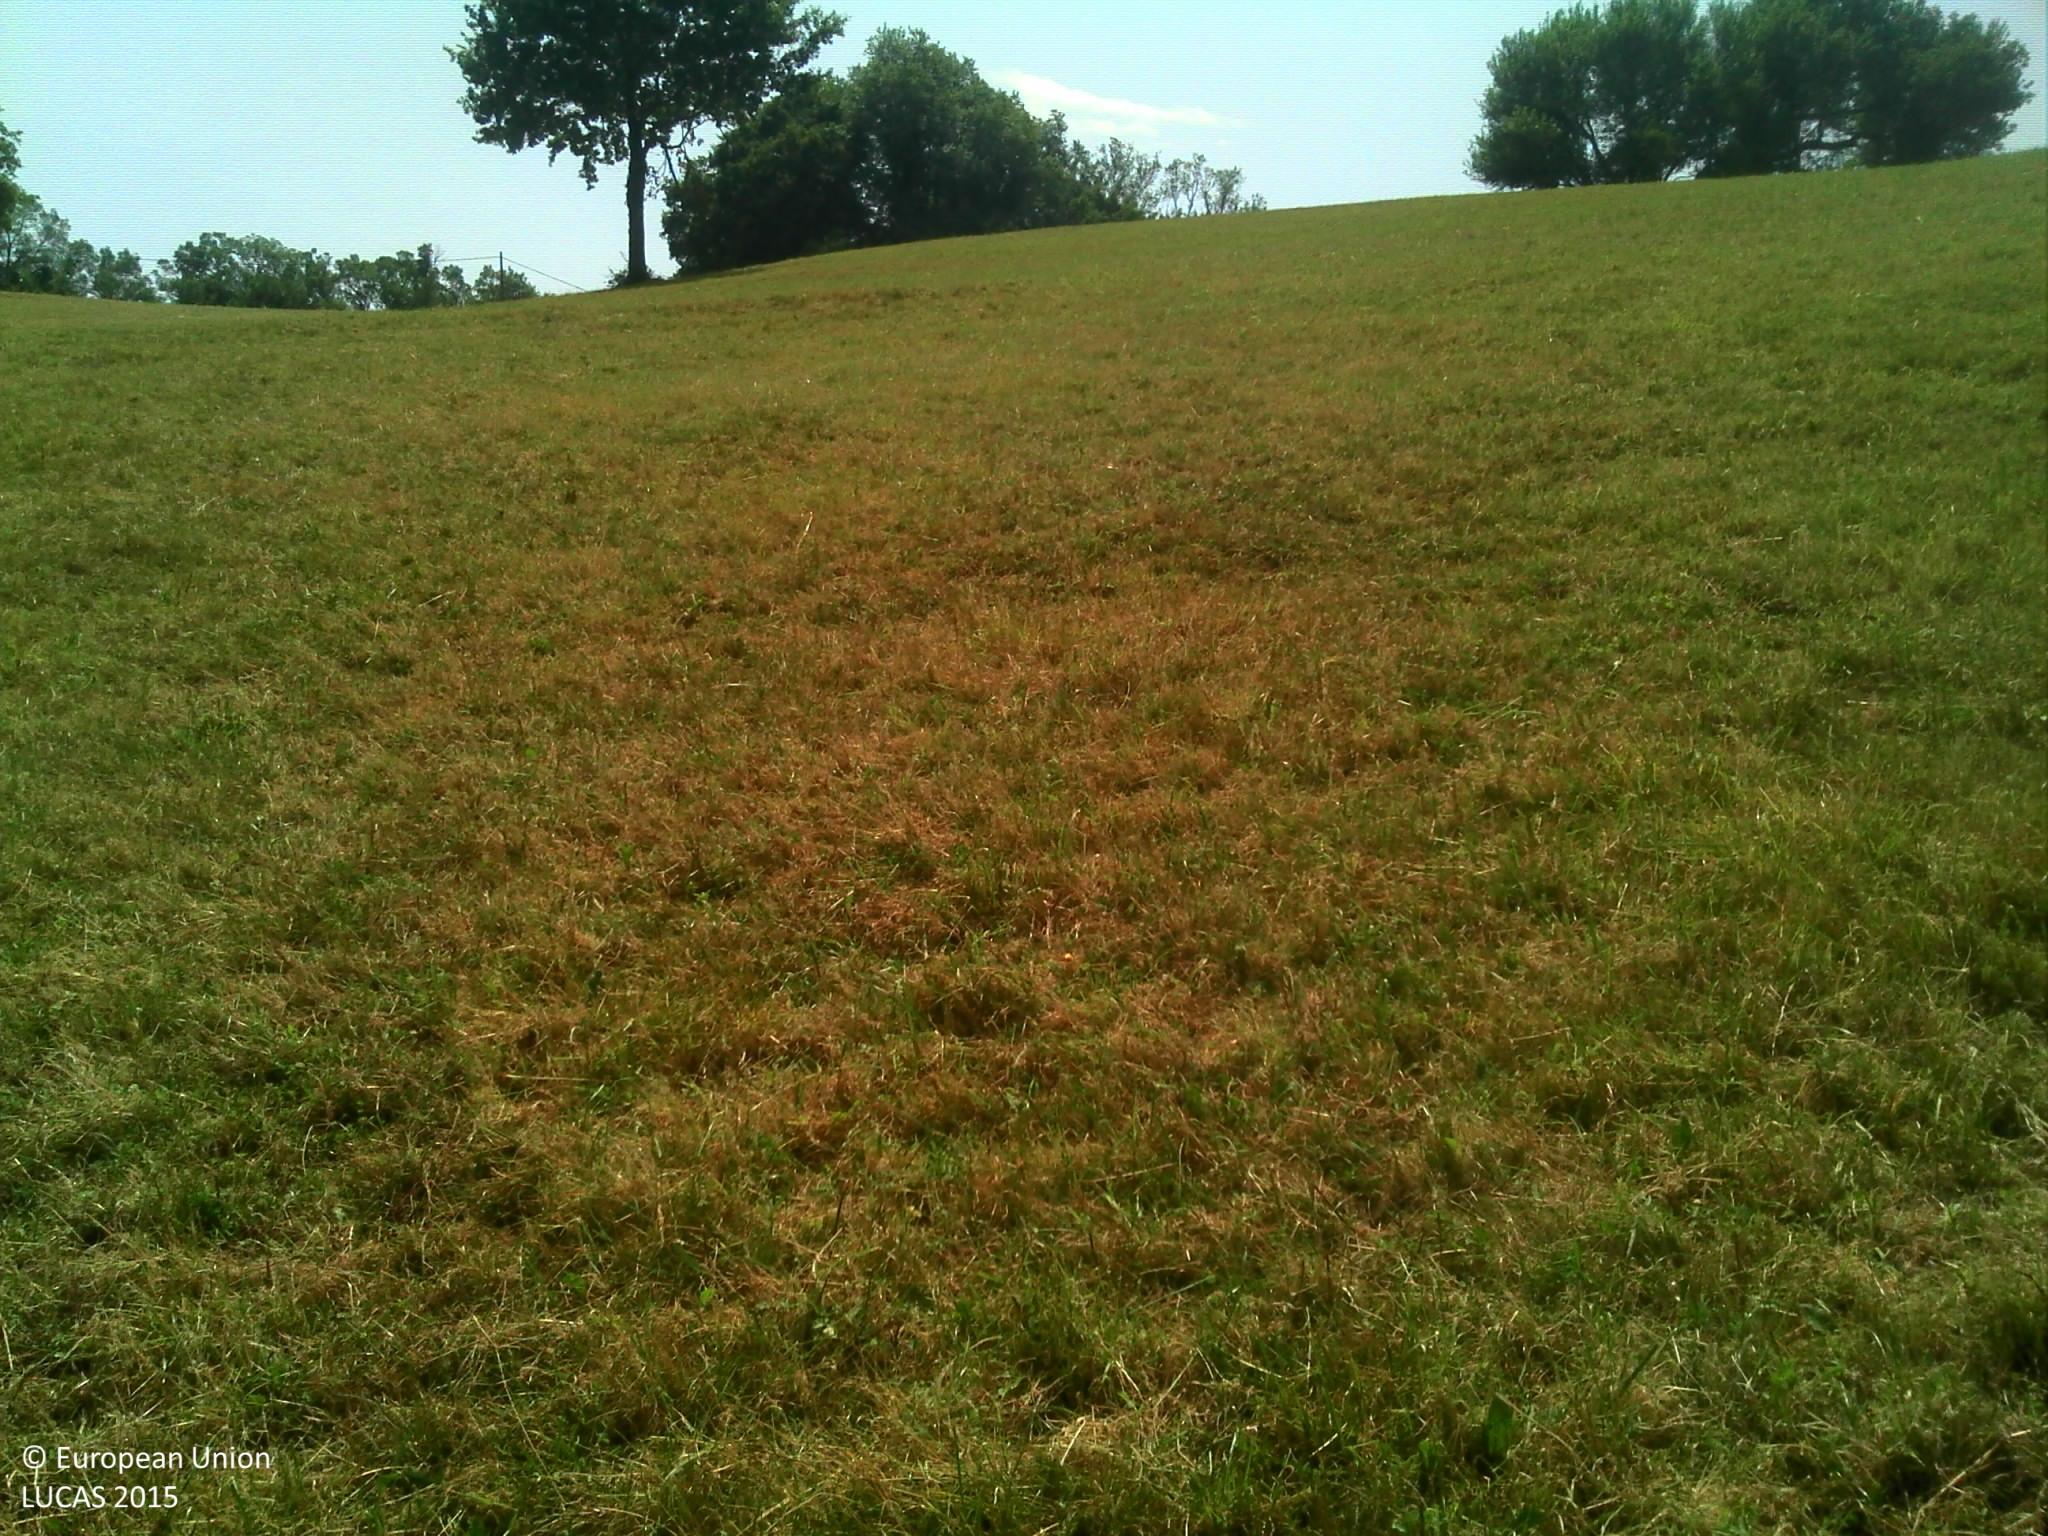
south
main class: Grassland
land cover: Grassland without tree/shrub cover
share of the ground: > 75 %
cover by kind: herbaceous plants 100 %
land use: Agriculture (excluding fallow land and kitchen gardens)
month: July
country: FR
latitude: 43.3275
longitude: 0.8381
